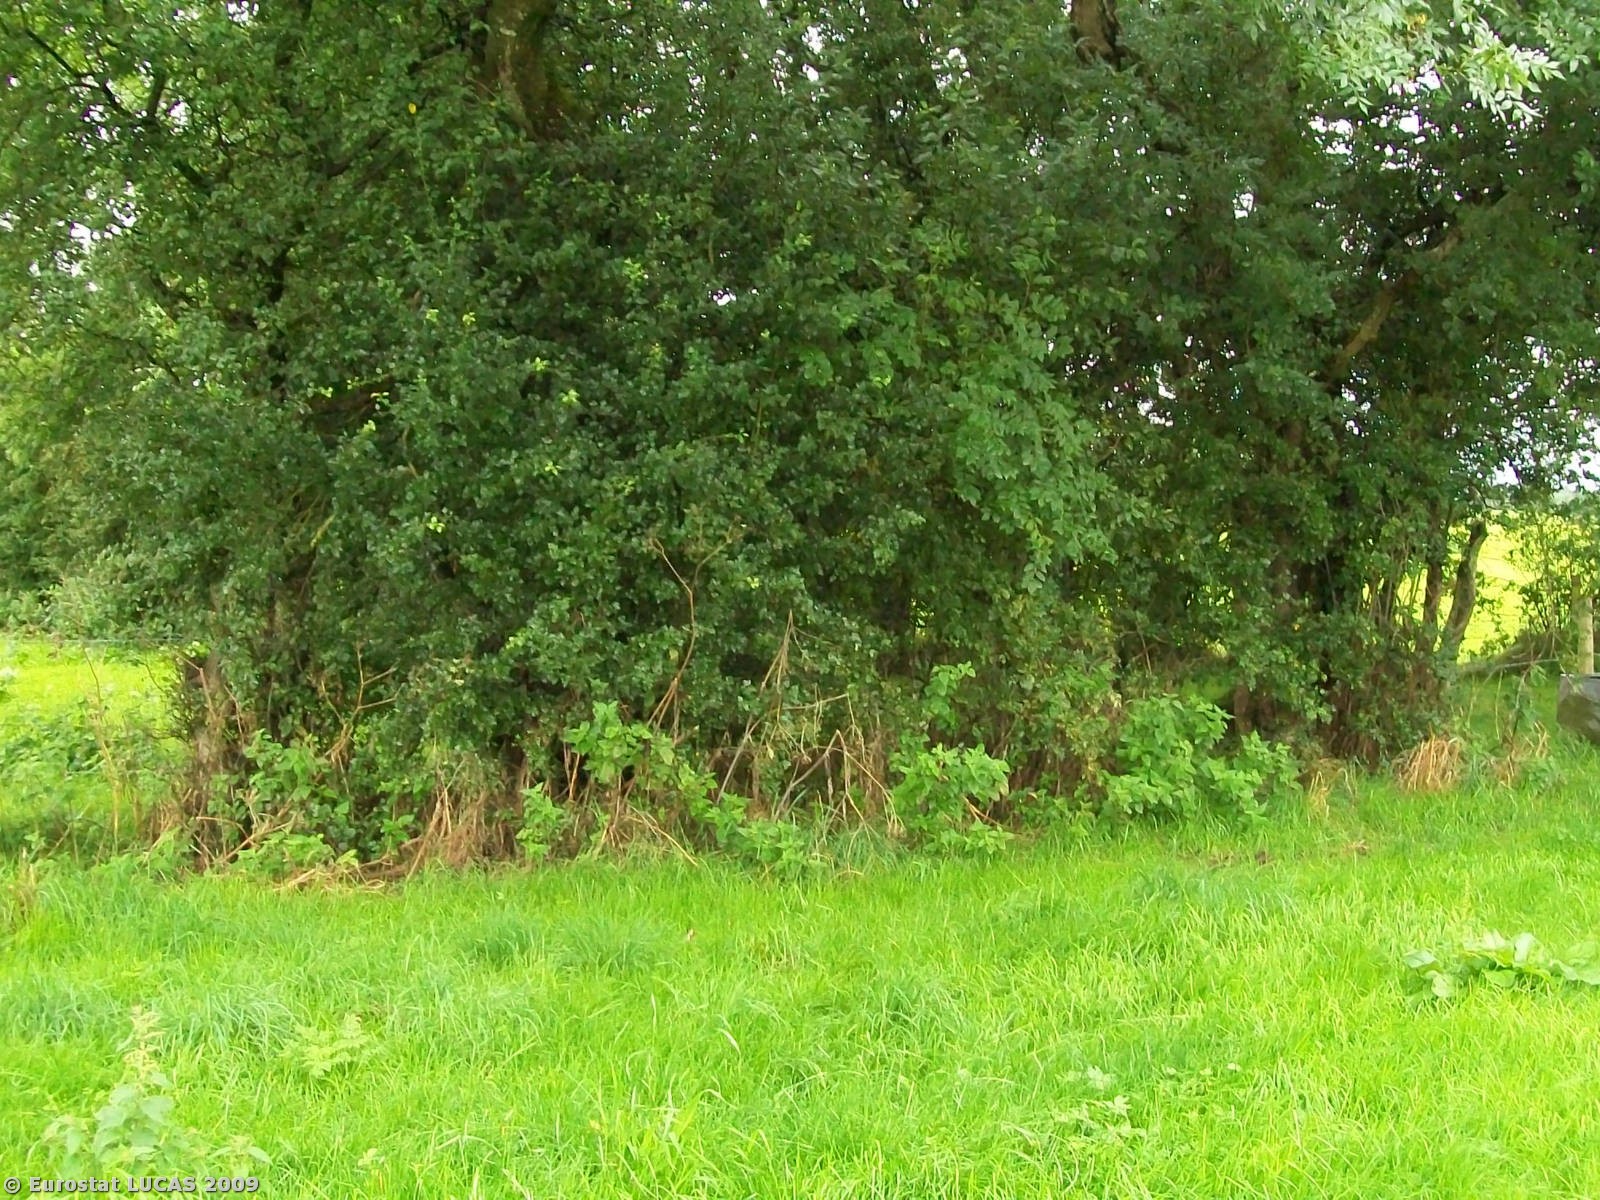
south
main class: Grassland
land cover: Grassland without tree/shrub cover
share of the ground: > 75 %
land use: Agriculture (excluding fallow land and kitchen gardens)
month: August
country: GB
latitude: 54.6438
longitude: -6.1201
